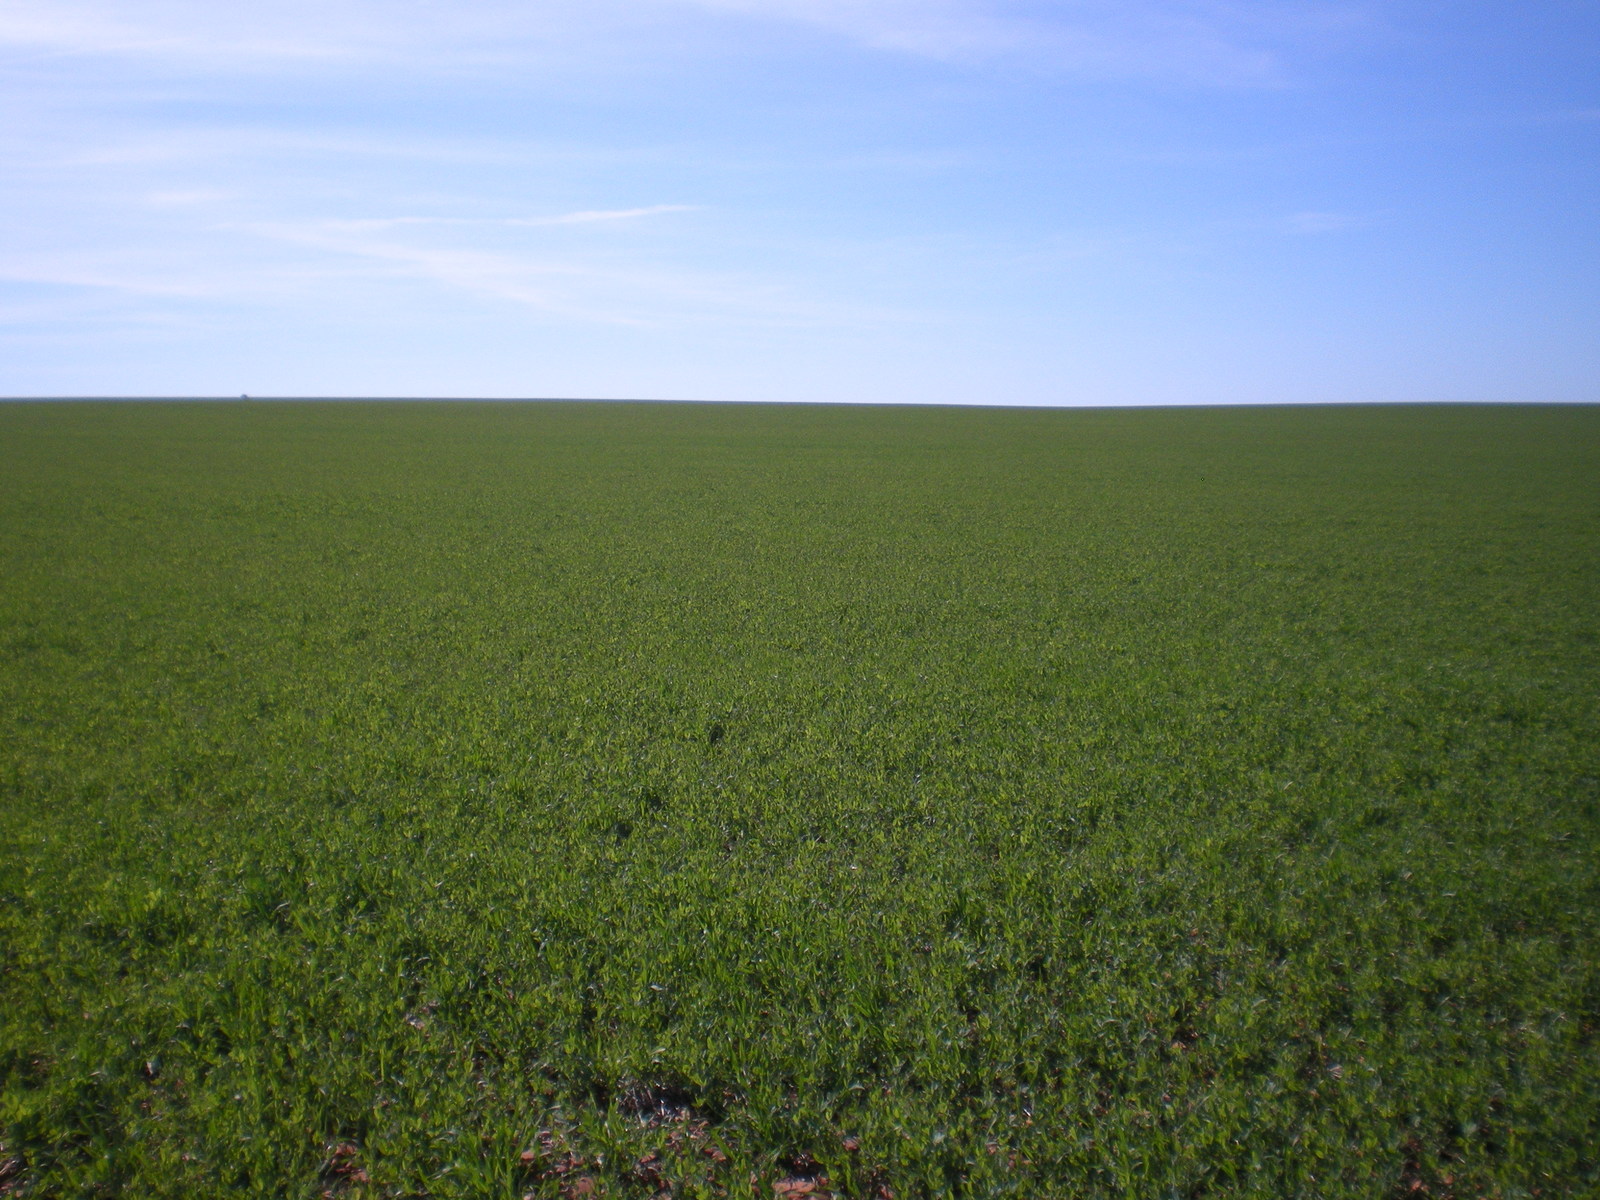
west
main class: Cropland
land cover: Dry pulses
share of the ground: > 75 %
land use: Agriculture (excluding fallow land and kitchen gardens)
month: March
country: ES
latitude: 39.0537
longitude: -3.2446
